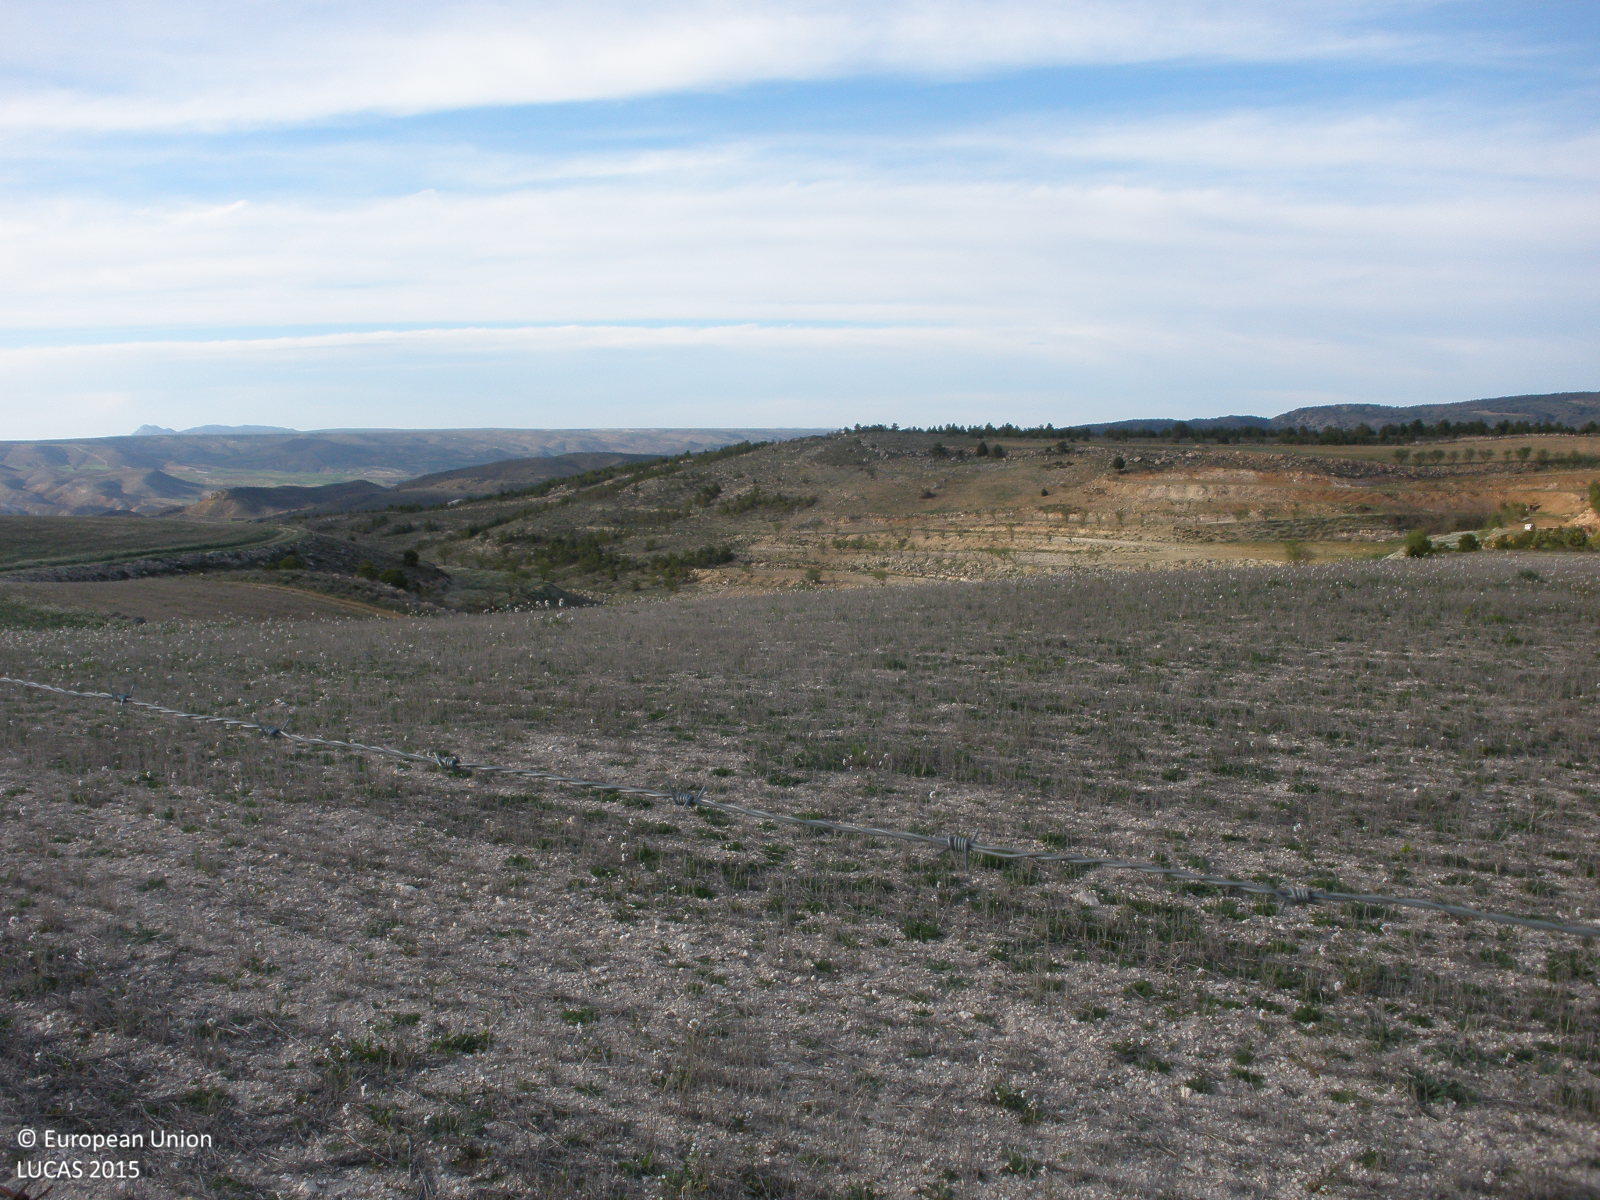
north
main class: Grassland
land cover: Spontaneously vegetated surfaces
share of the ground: > 75 %
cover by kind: herbaceous plants 70 %, unconsolidated bare surface 30 %
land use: Agriculture (excluding fallow land and kitchen gardens)
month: April
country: ES
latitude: 40.3508
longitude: -1.0659
